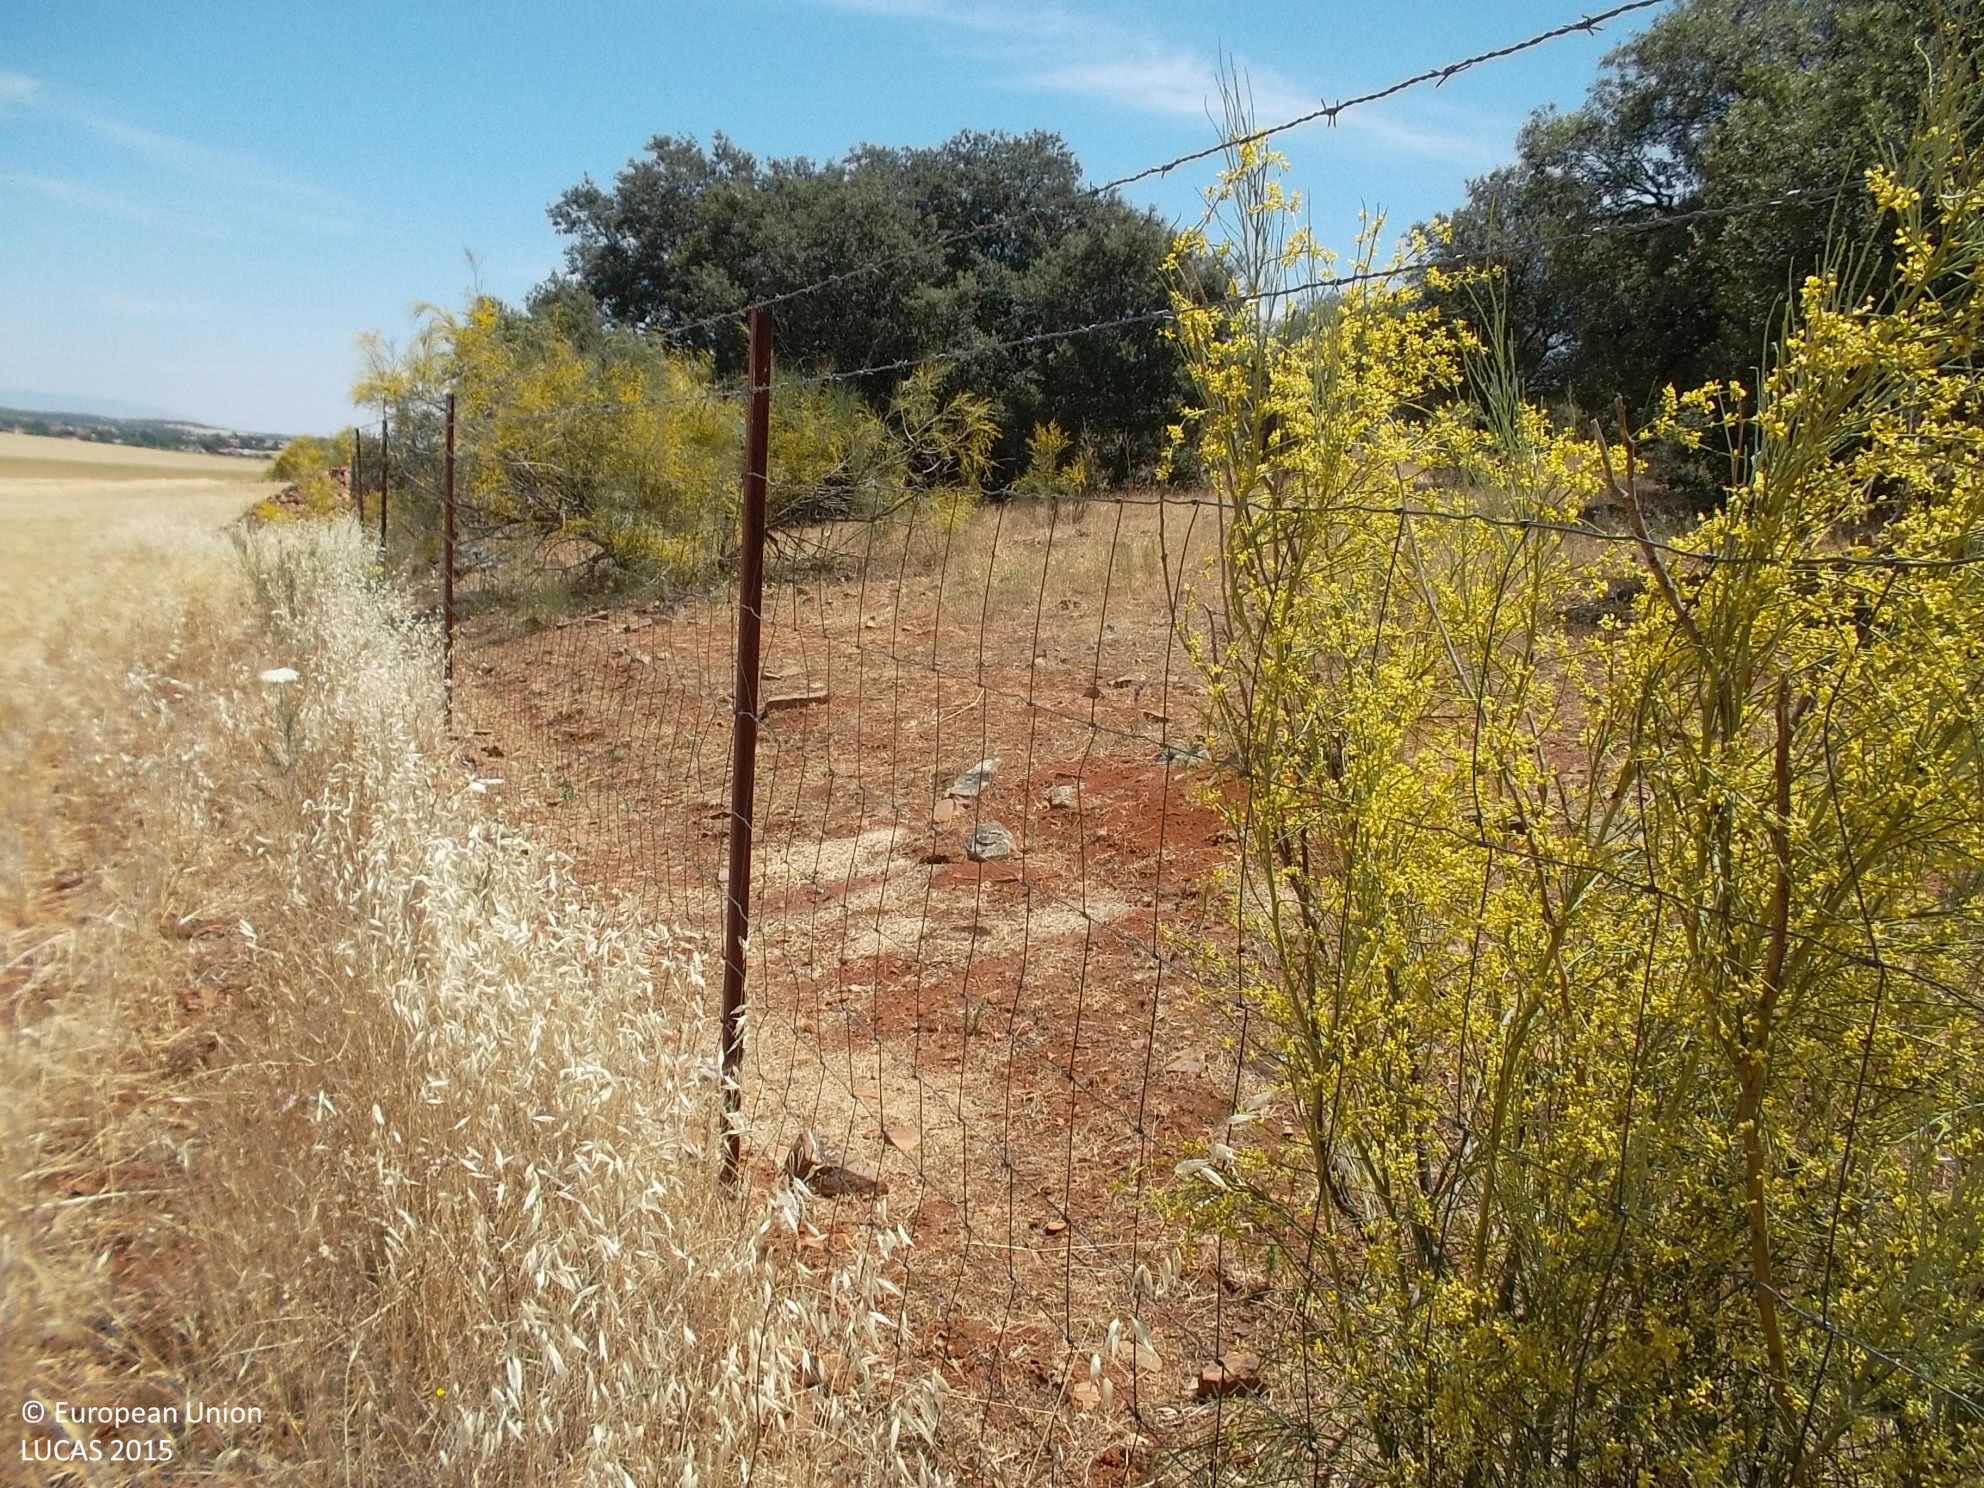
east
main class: Woodland
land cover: Broadleaved woodland
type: broadleaved evergreen forest
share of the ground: 25 - 50 %
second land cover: Spontaneously vegetated surfaces
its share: > 75 %
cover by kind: broadleaved forest trees 40 %, shrubs 30 %, herbaceous plants 30 %
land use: Forestry
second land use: Agriculture (excluding fallow land and kitchen gardens)
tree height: > 5 m
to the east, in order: Broadleaved woodland; Spontaneously vegetated surfaces; Fences; Grassland without tree/shrub cover
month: June
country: ES
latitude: 39.0183
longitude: -4.0087
